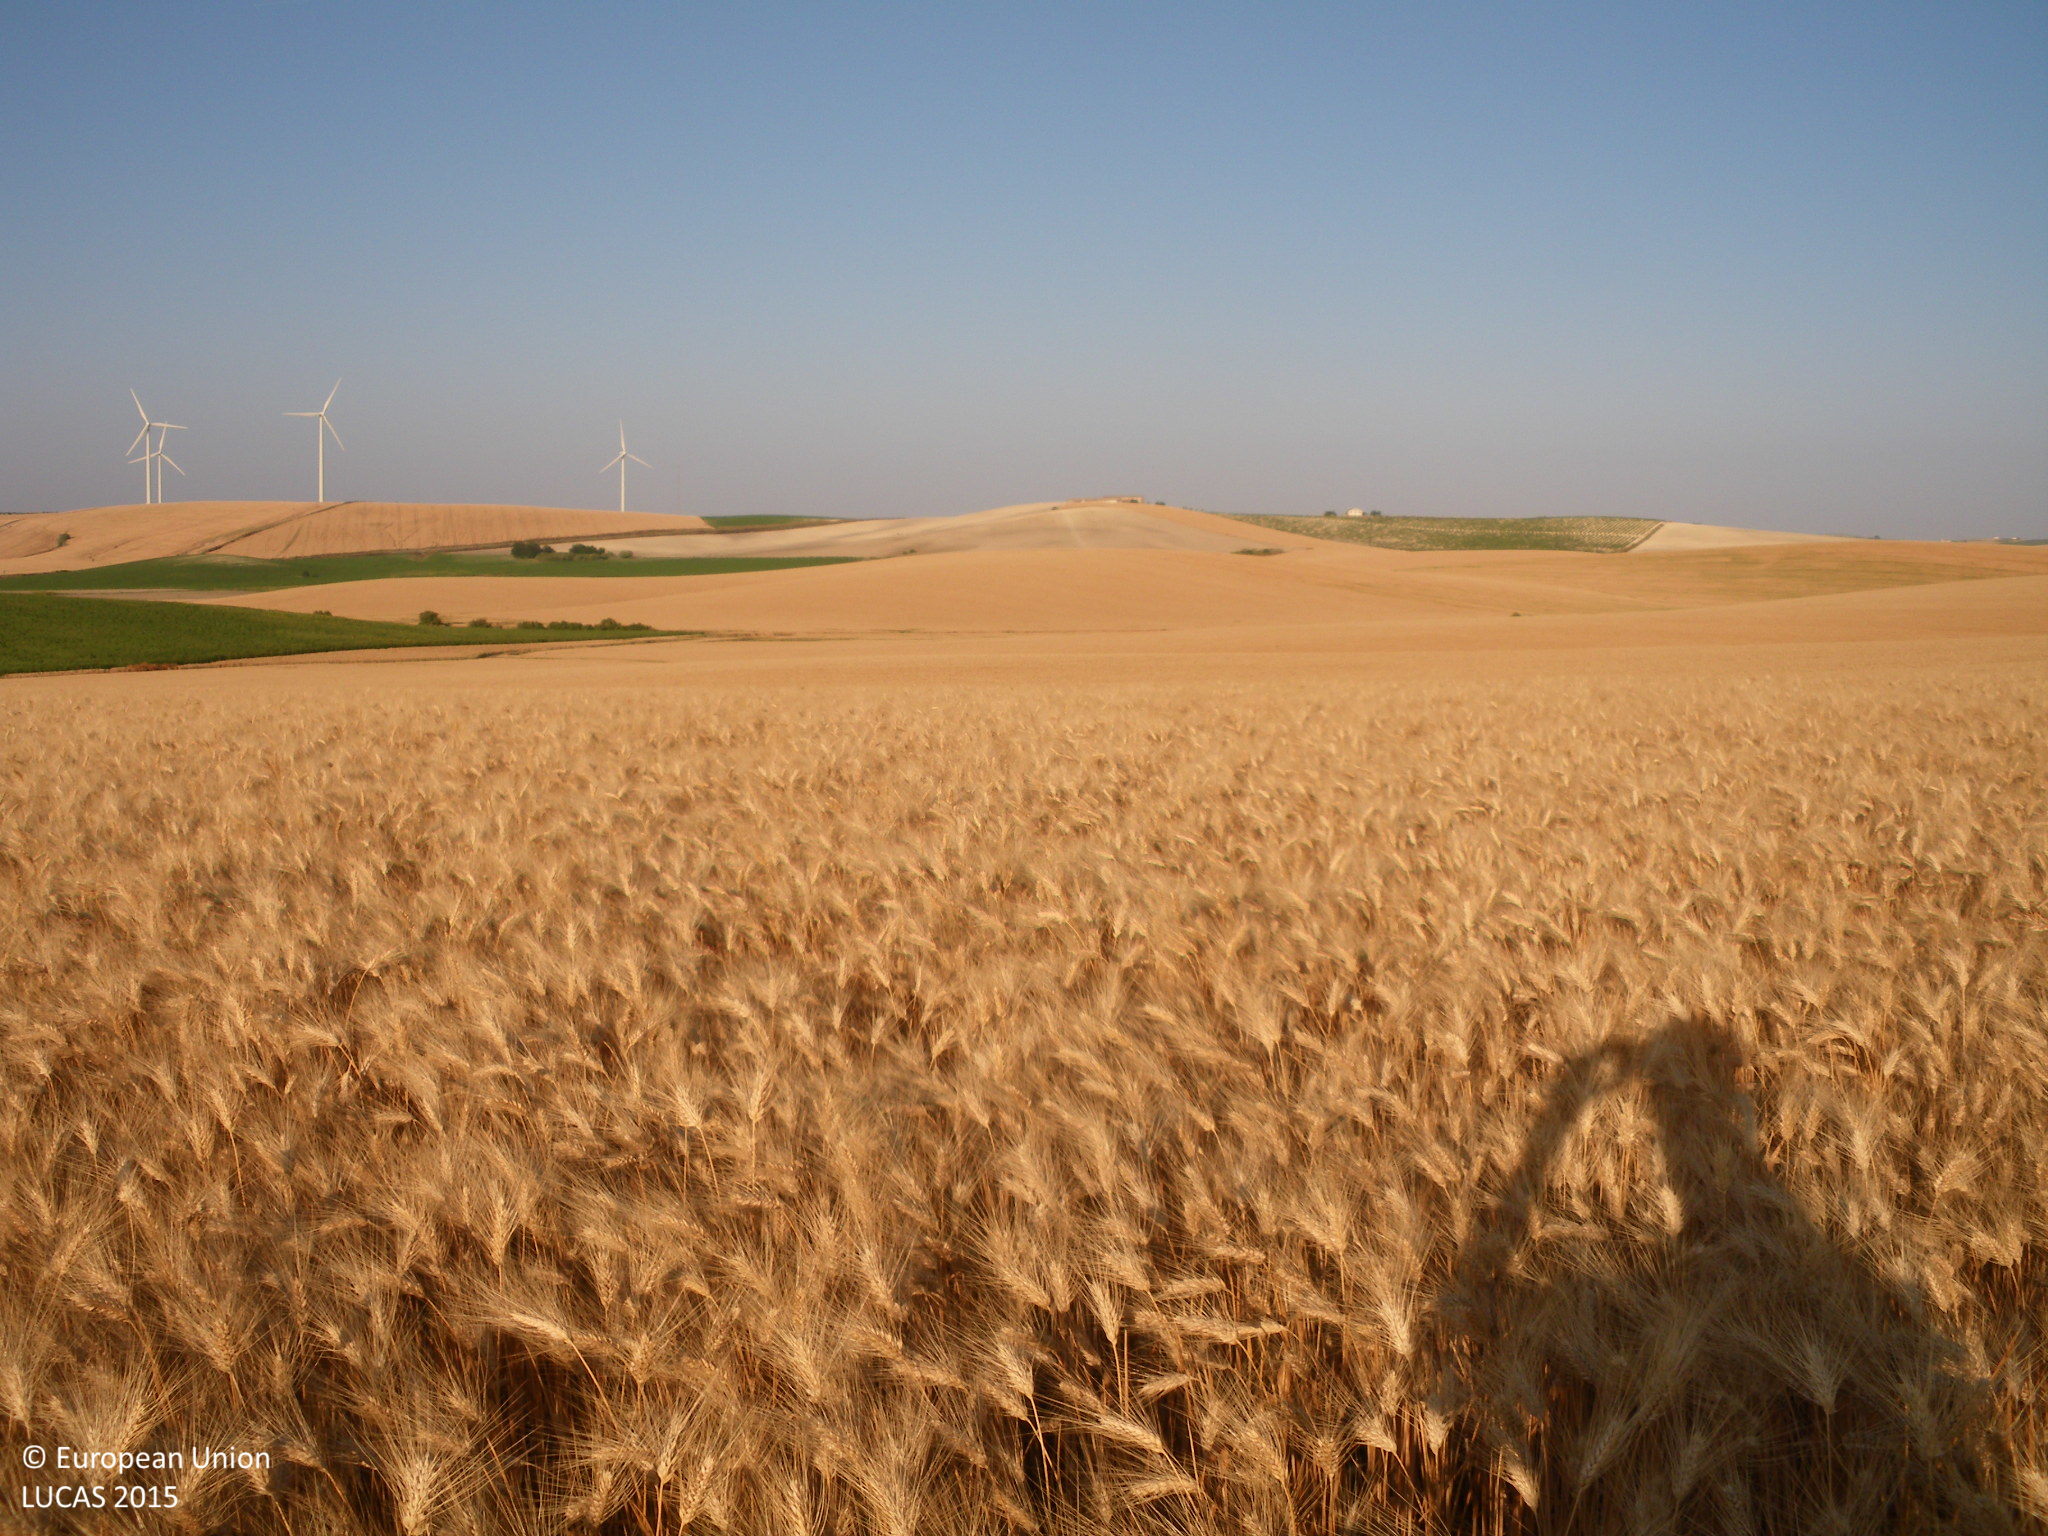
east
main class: Cropland
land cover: Durum wheat
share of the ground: > 75 %
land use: Agriculture (excluding fallow land and kitchen gardens)
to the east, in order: Durum wheat
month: May
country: ES
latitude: 36.7606
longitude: -6.2700
